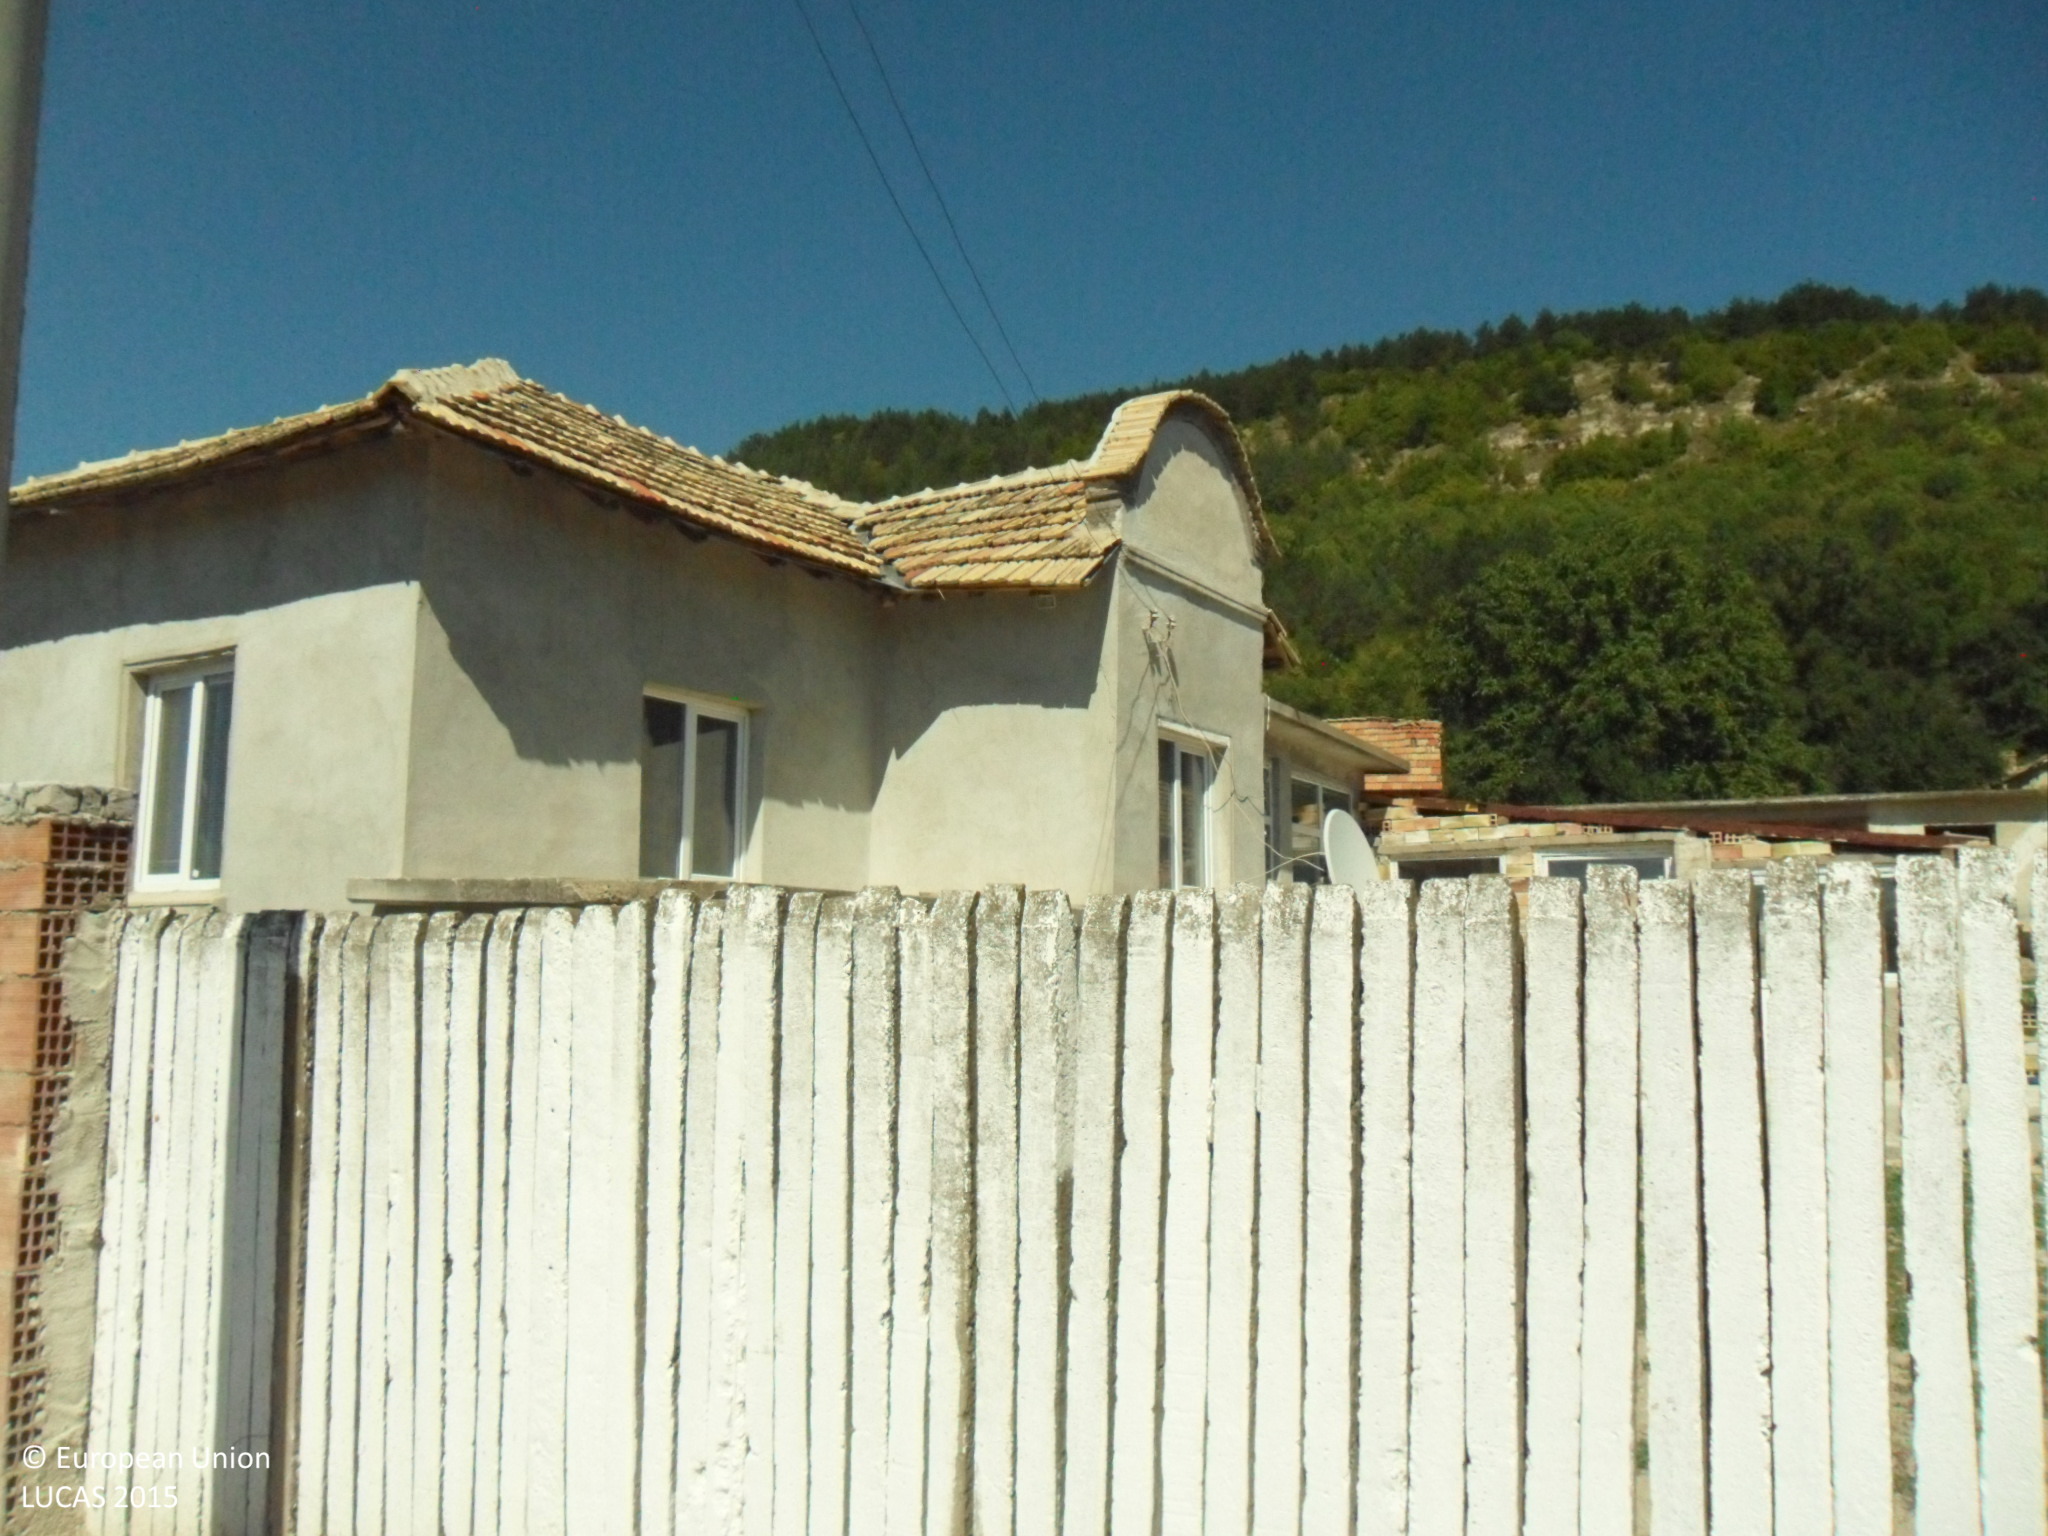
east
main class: Grassland
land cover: Grassland without tree/shrub cover
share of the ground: > 75 %
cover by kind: herbaceous plants 85 %, unconsolidated bare surface 10 %, shrubs 5 %
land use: Residential
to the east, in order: Artificial constructions in urban areas; Spontaneously vegetated surfaces; Artificial constructions in urban areas; Pine dominated mixed woodland
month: September
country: BG
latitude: 43.2278
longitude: 26.7919
